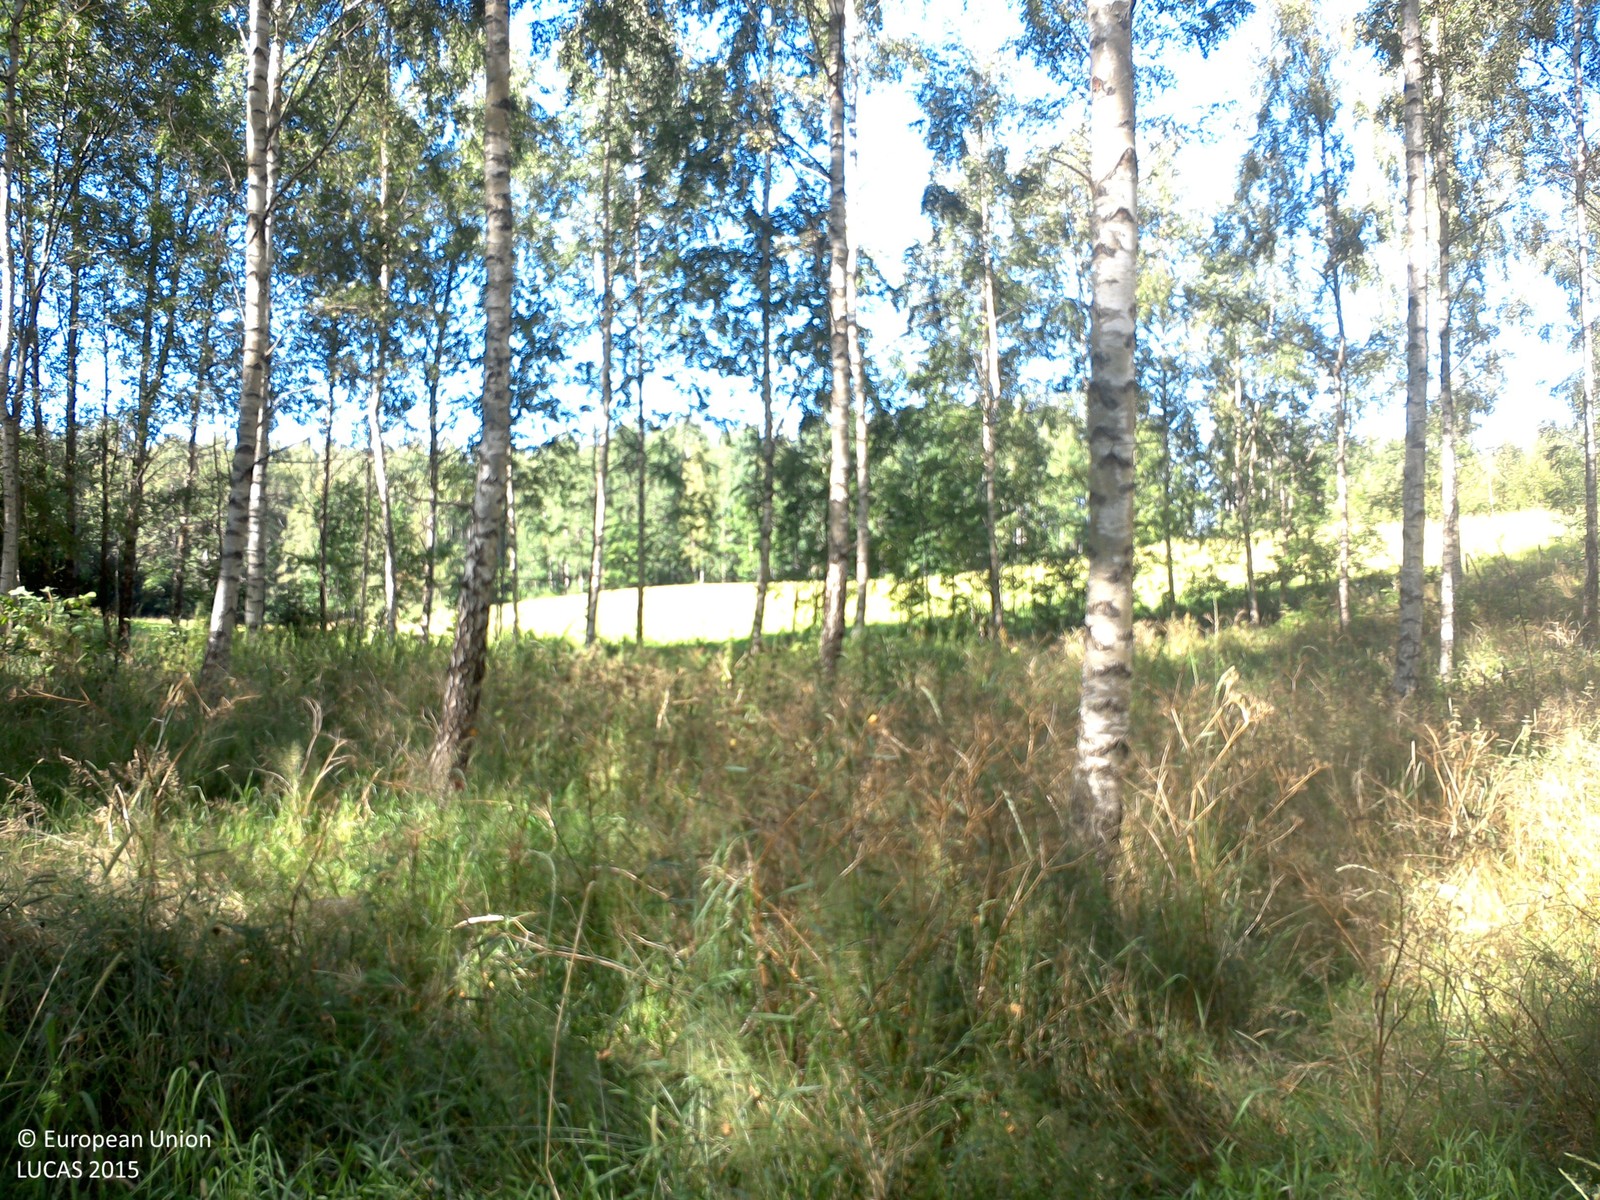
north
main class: Woodland
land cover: Broadleaved woodland
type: hemiboreal forest and nemoral coniferous forest and mixed broadleaved-coniferous forest
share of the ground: 25 - 50 %
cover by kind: herbaceous plants 60 %, broadleaved forest trees 40 %
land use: Forestry
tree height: > 5 m
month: August
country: SE
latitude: 58.2429
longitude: 15.2583
